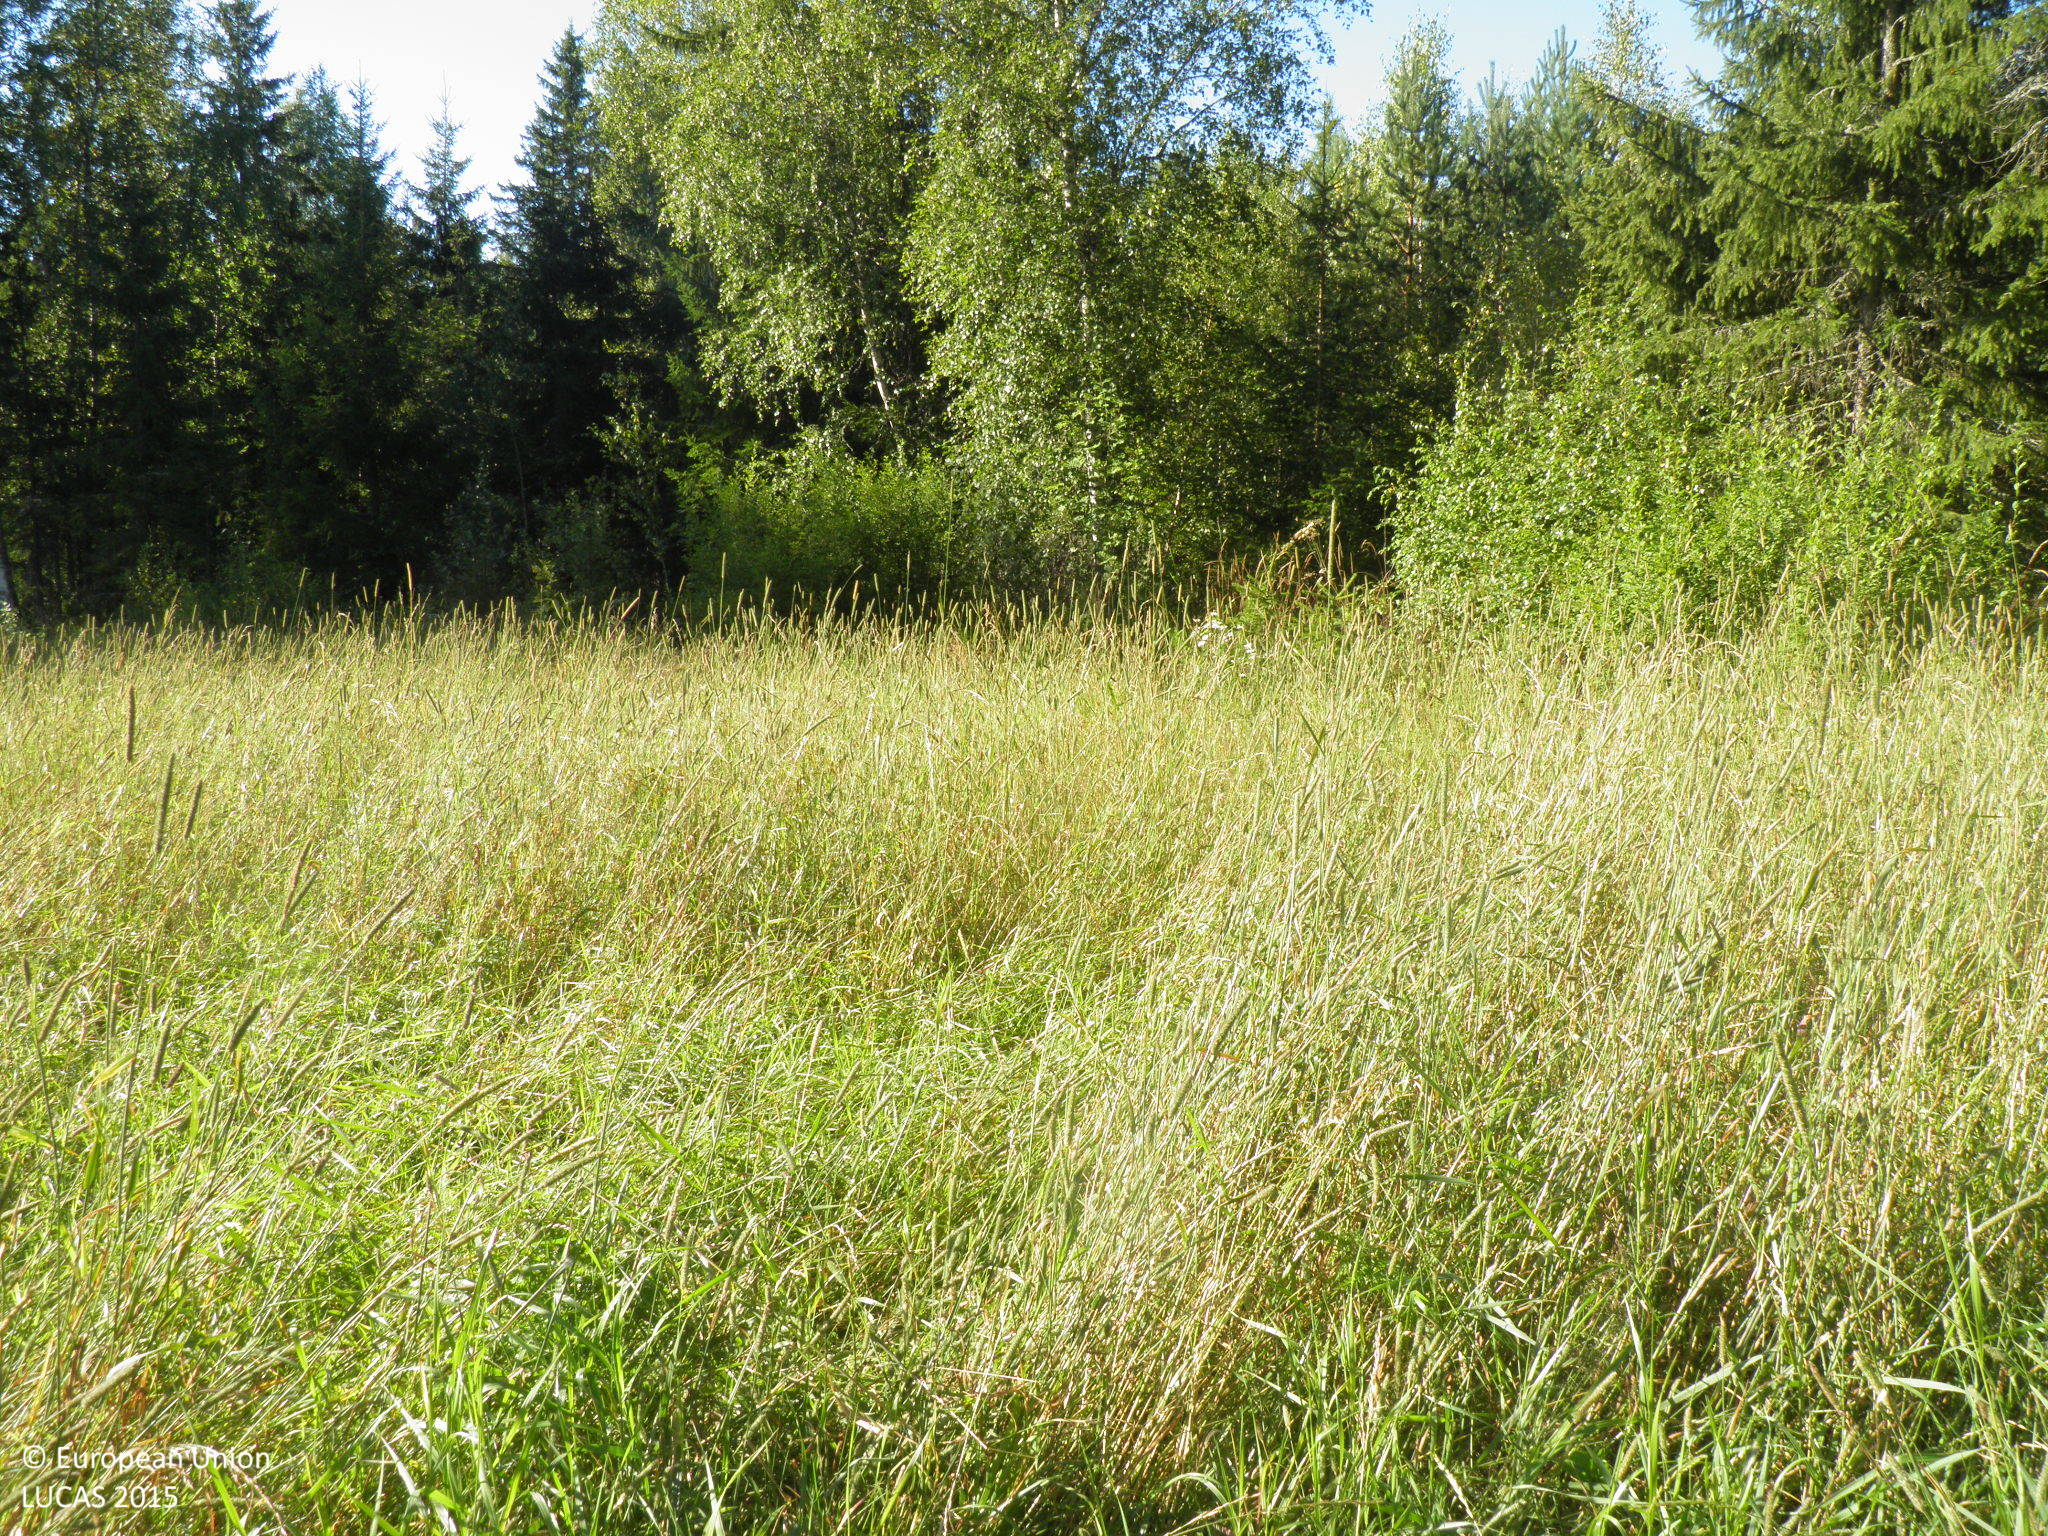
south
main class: Grassland
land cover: Grassland without tree/shrub cover
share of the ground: > 75 %
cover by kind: herbaceous plants 95 %, shrubs 5 %
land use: Abandoned areas
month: August
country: FI
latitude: 60.7841
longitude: 21.7204
